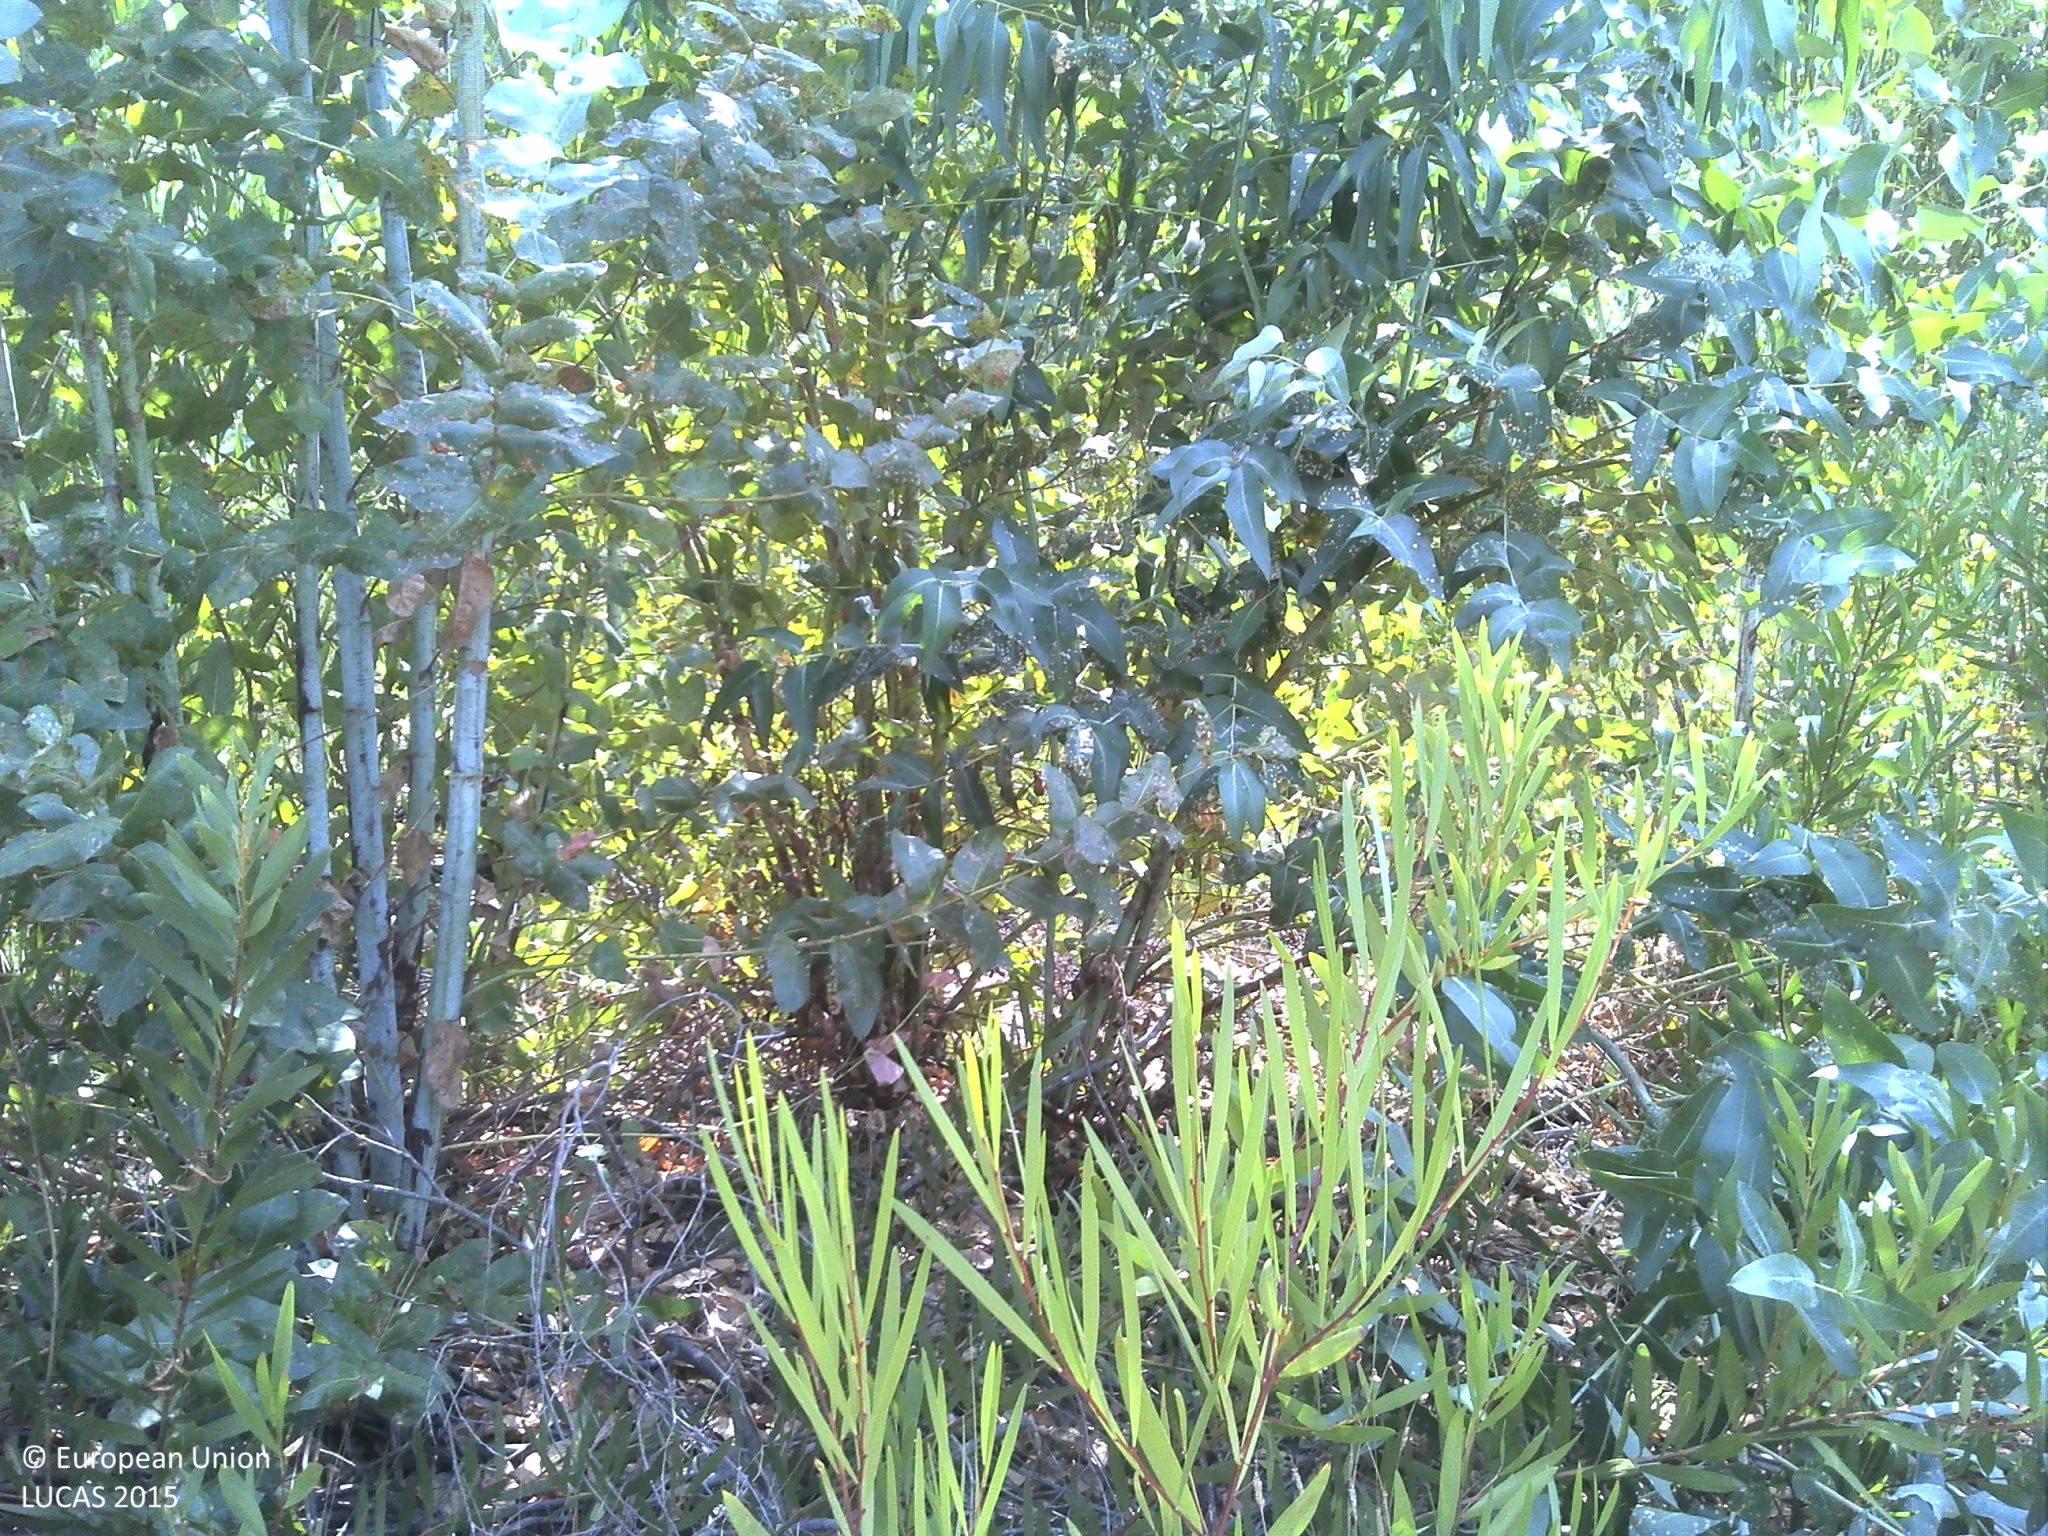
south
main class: Woodland
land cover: Pine dominated mixed woodland
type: coniferous forest of the mediterranean region
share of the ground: 25 - 50 %
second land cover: Shrubland without tree cover
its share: 10 - 25 %
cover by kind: unconsolidated bare surface 35 %, coniferous forest trees 30 %, broadleaved forest trees 20 %, shrubs 15 %
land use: Forestry
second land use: Agriculture (excluding fallow land and kitchen gardens)
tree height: > 5 m
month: August
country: PT
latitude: 38.7316
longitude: -8.5920
